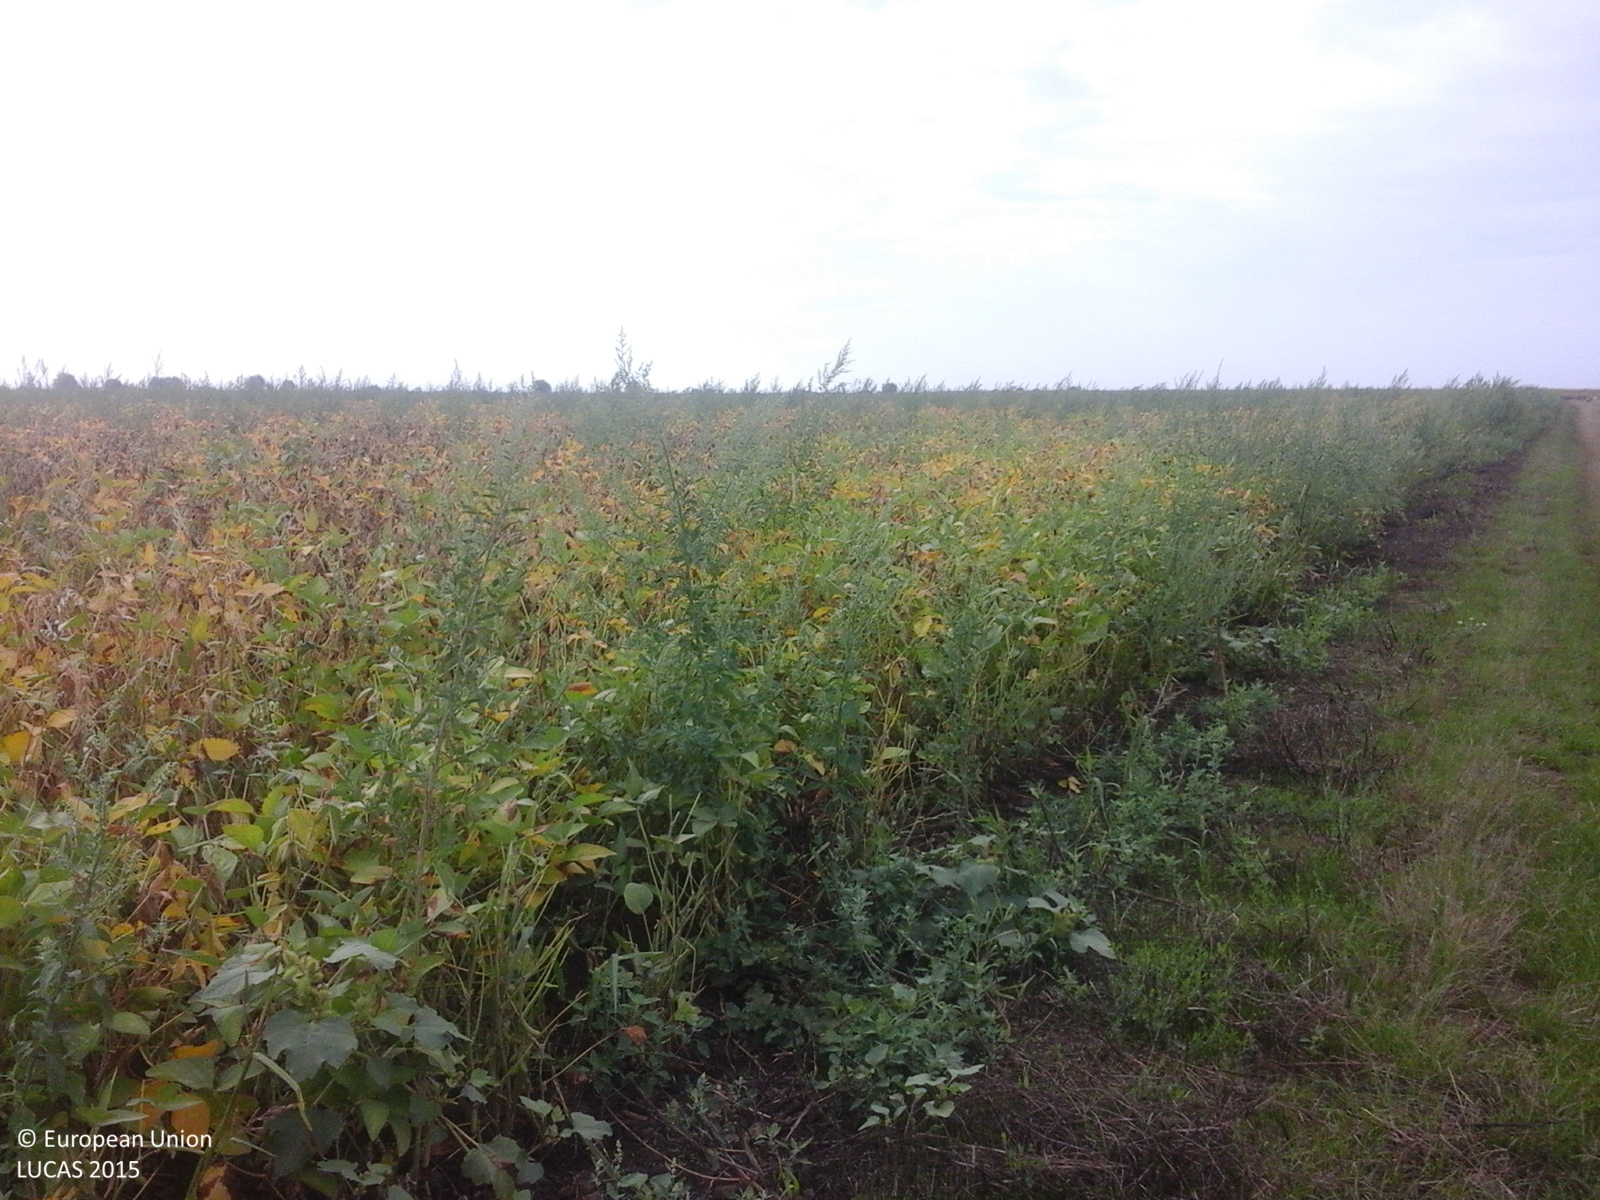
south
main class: Cropland
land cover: Soya
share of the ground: > 75 %
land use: Agriculture (excluding fallow land and kitchen gardens)
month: August
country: RO
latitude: 46.3009
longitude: 21.4218
